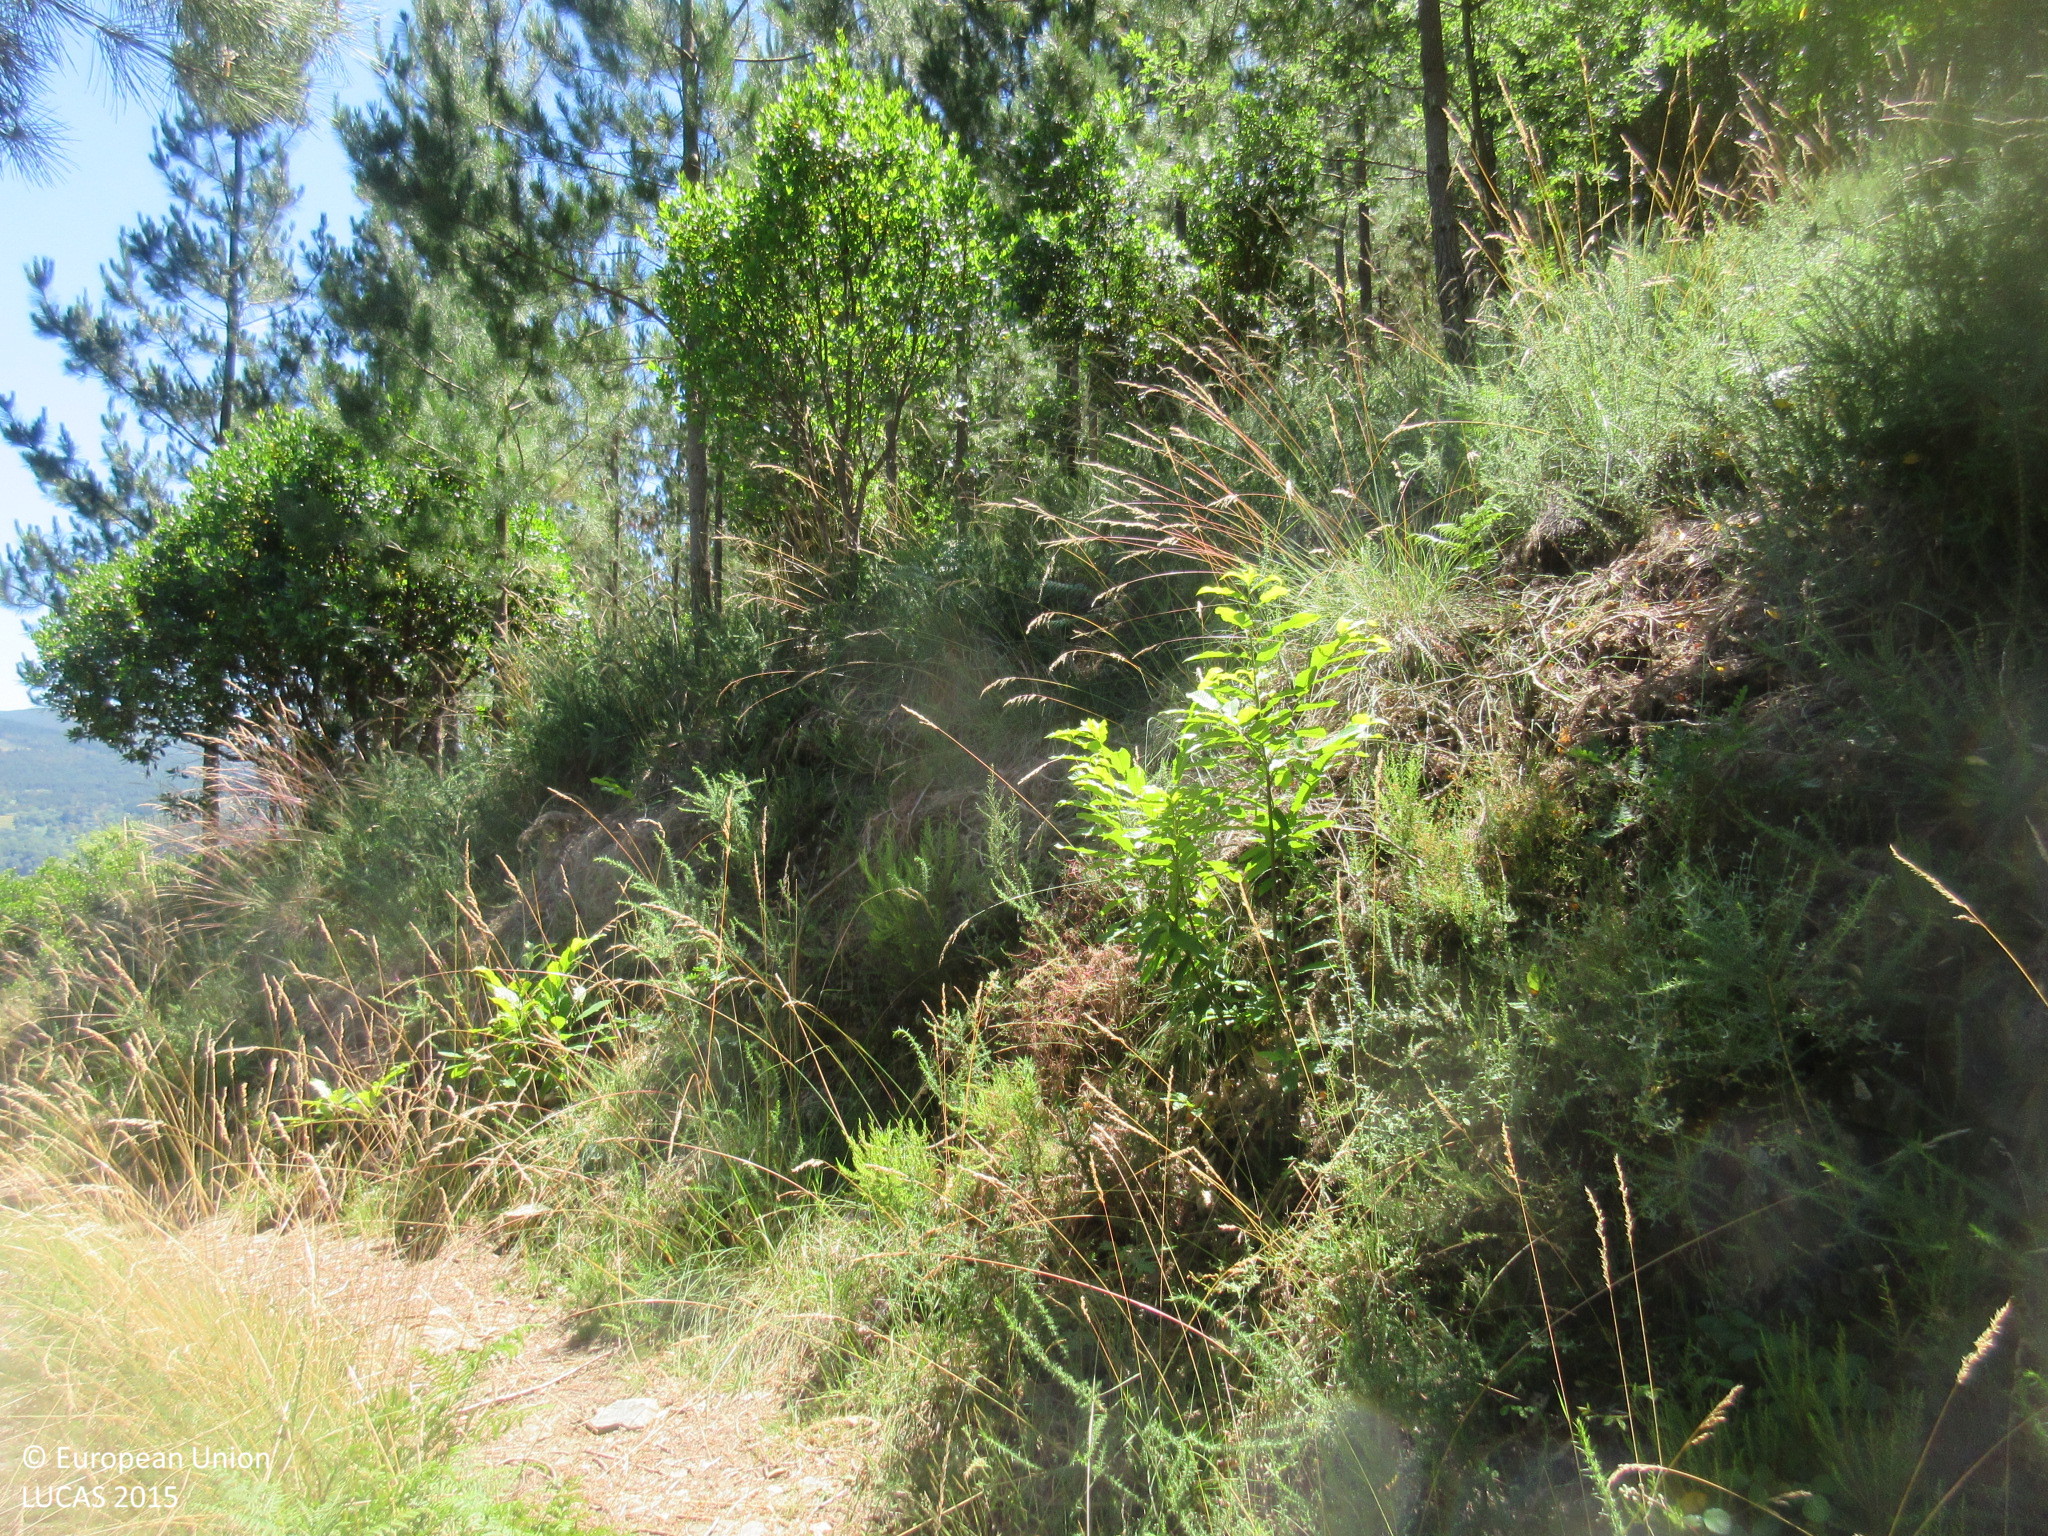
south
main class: Woodland
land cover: Pine dominated coniferous woodland
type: hemiboreal forest and nemoral coniferous forest and mixed broadleaved-coniferous forest
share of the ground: > 75 %
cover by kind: coniferous forest trees 85 %, shrubs 15 %
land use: Forestry
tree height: > 5 m
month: June
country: ES
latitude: 43.0458
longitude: -6.8900
